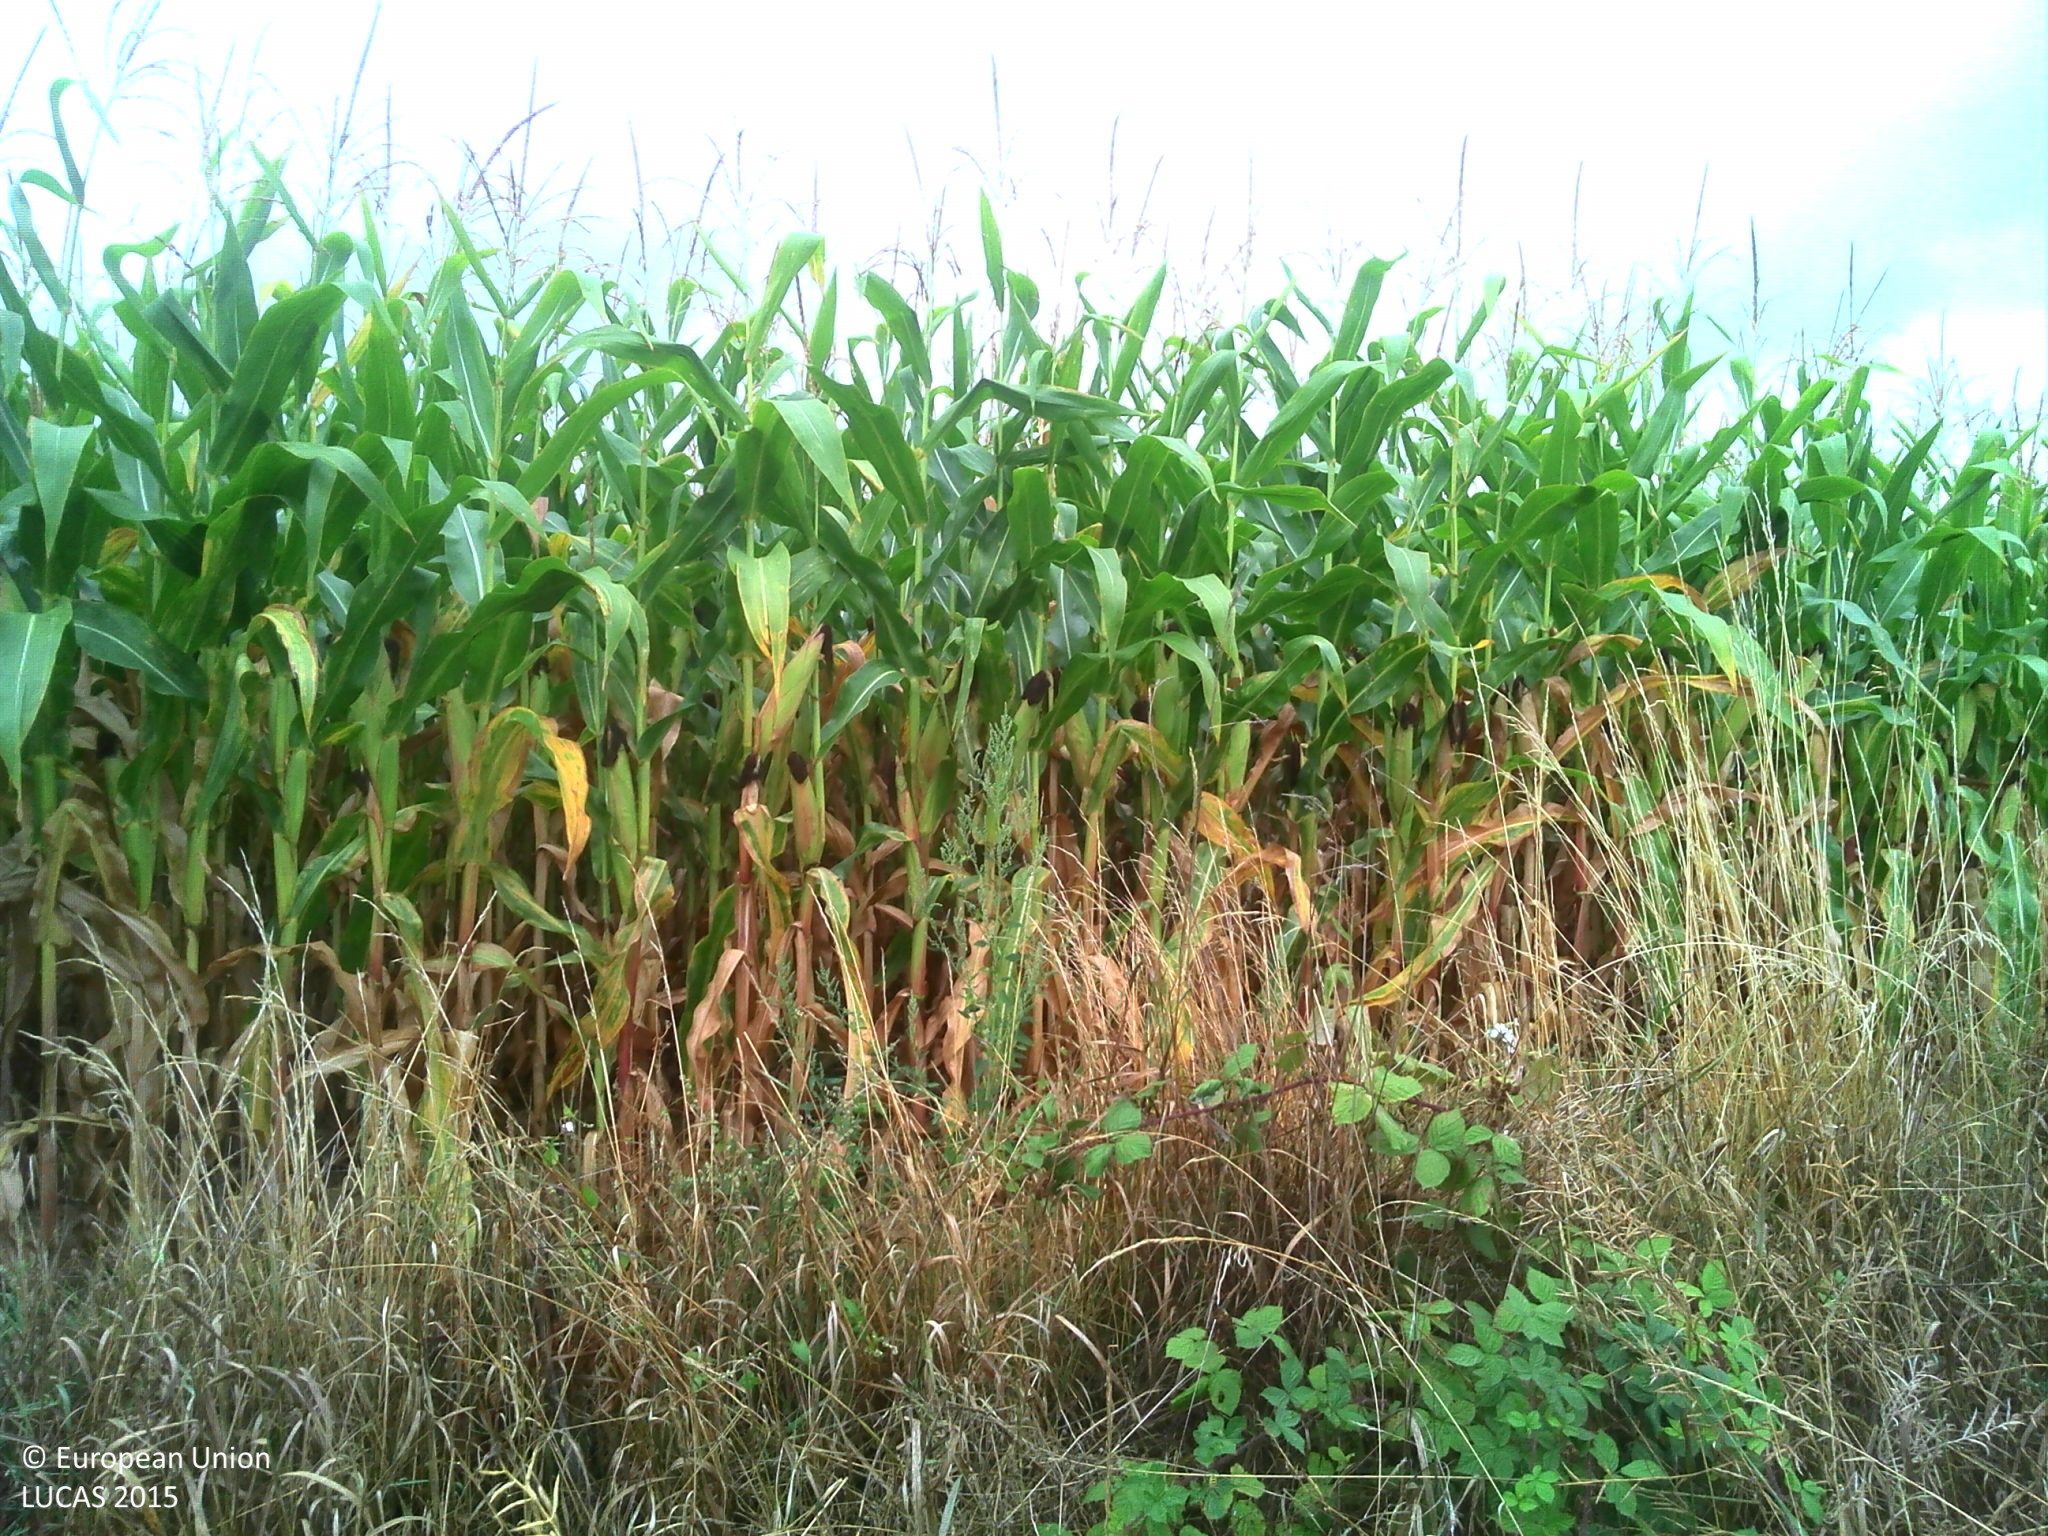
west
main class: Cropland
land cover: Maize
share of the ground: > 75 %
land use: Agriculture (excluding fallow land and kitchen gardens)
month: August
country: FR
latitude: 49.0627
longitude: 2.3921
